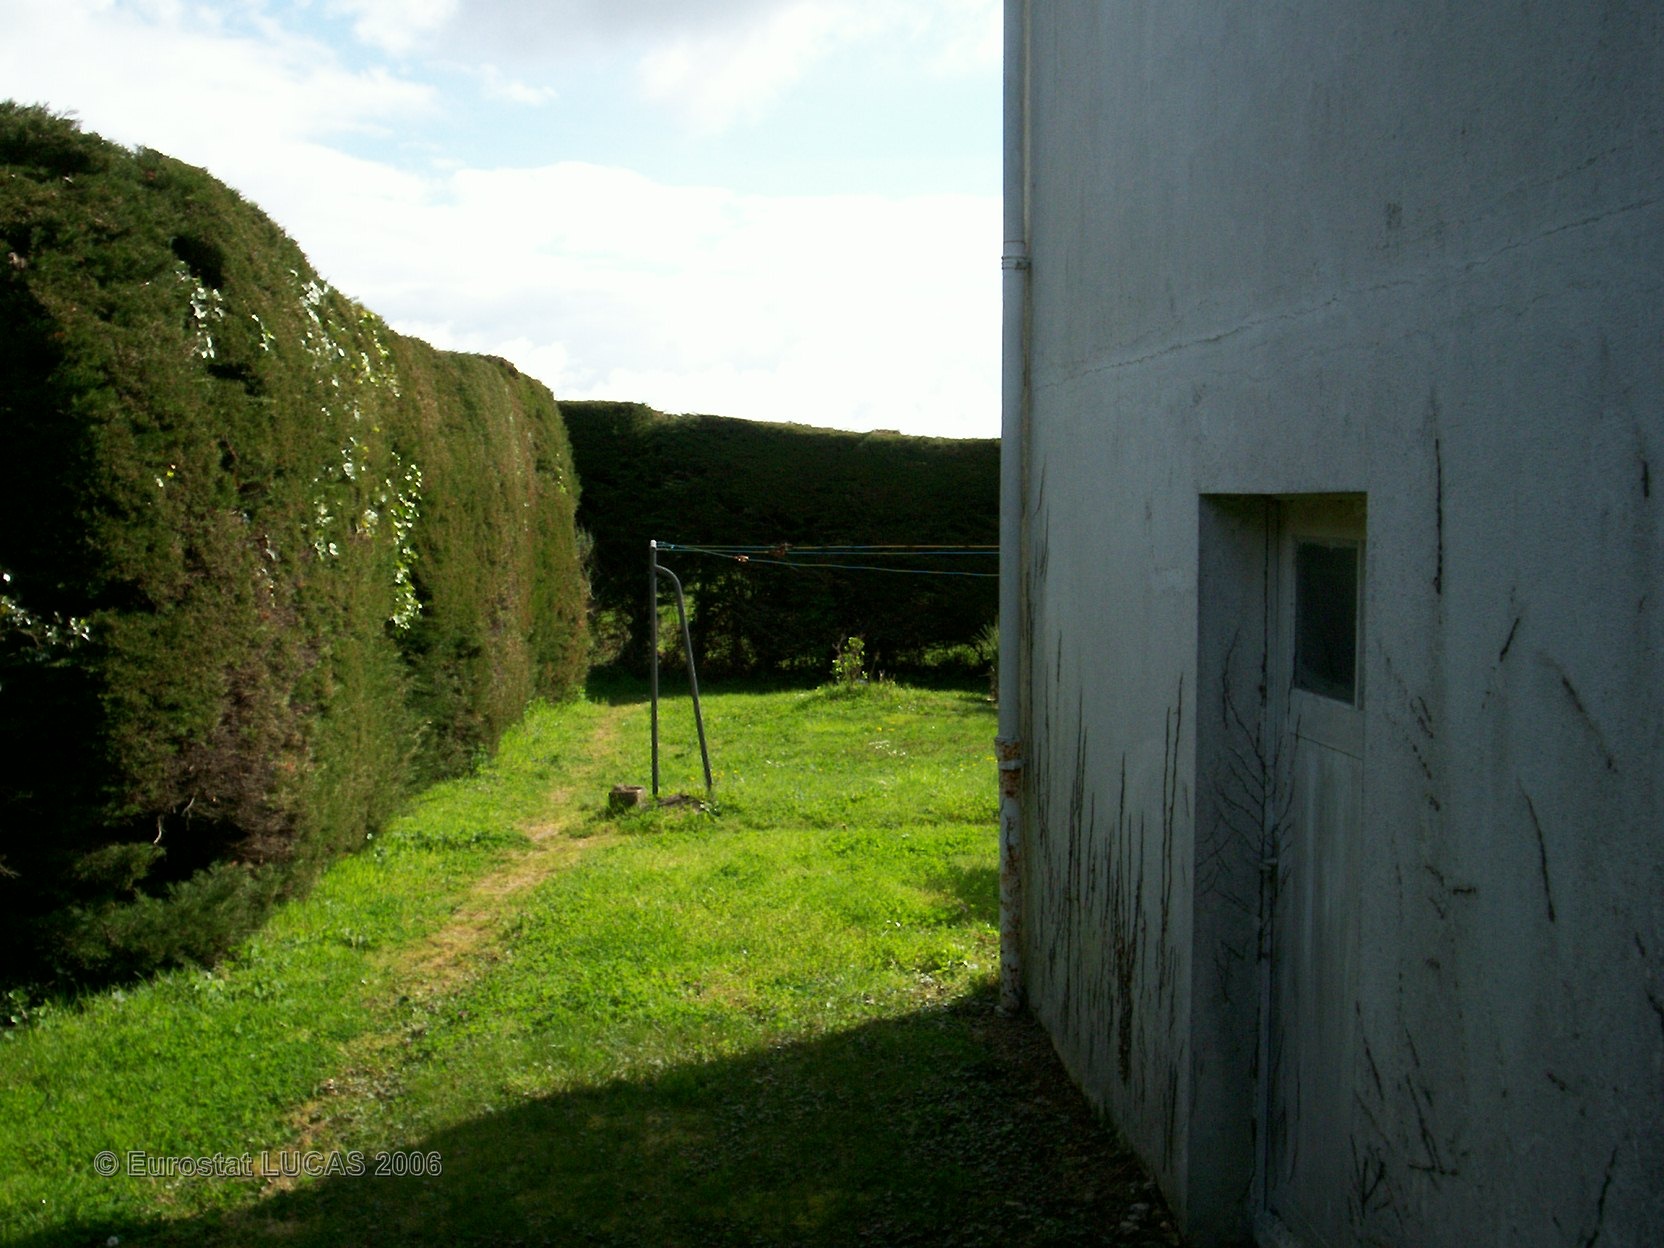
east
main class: Grassland
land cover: Grassland without tree/shrub cover
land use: Residential
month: April
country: FR
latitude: 47.7059
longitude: -3.4411
